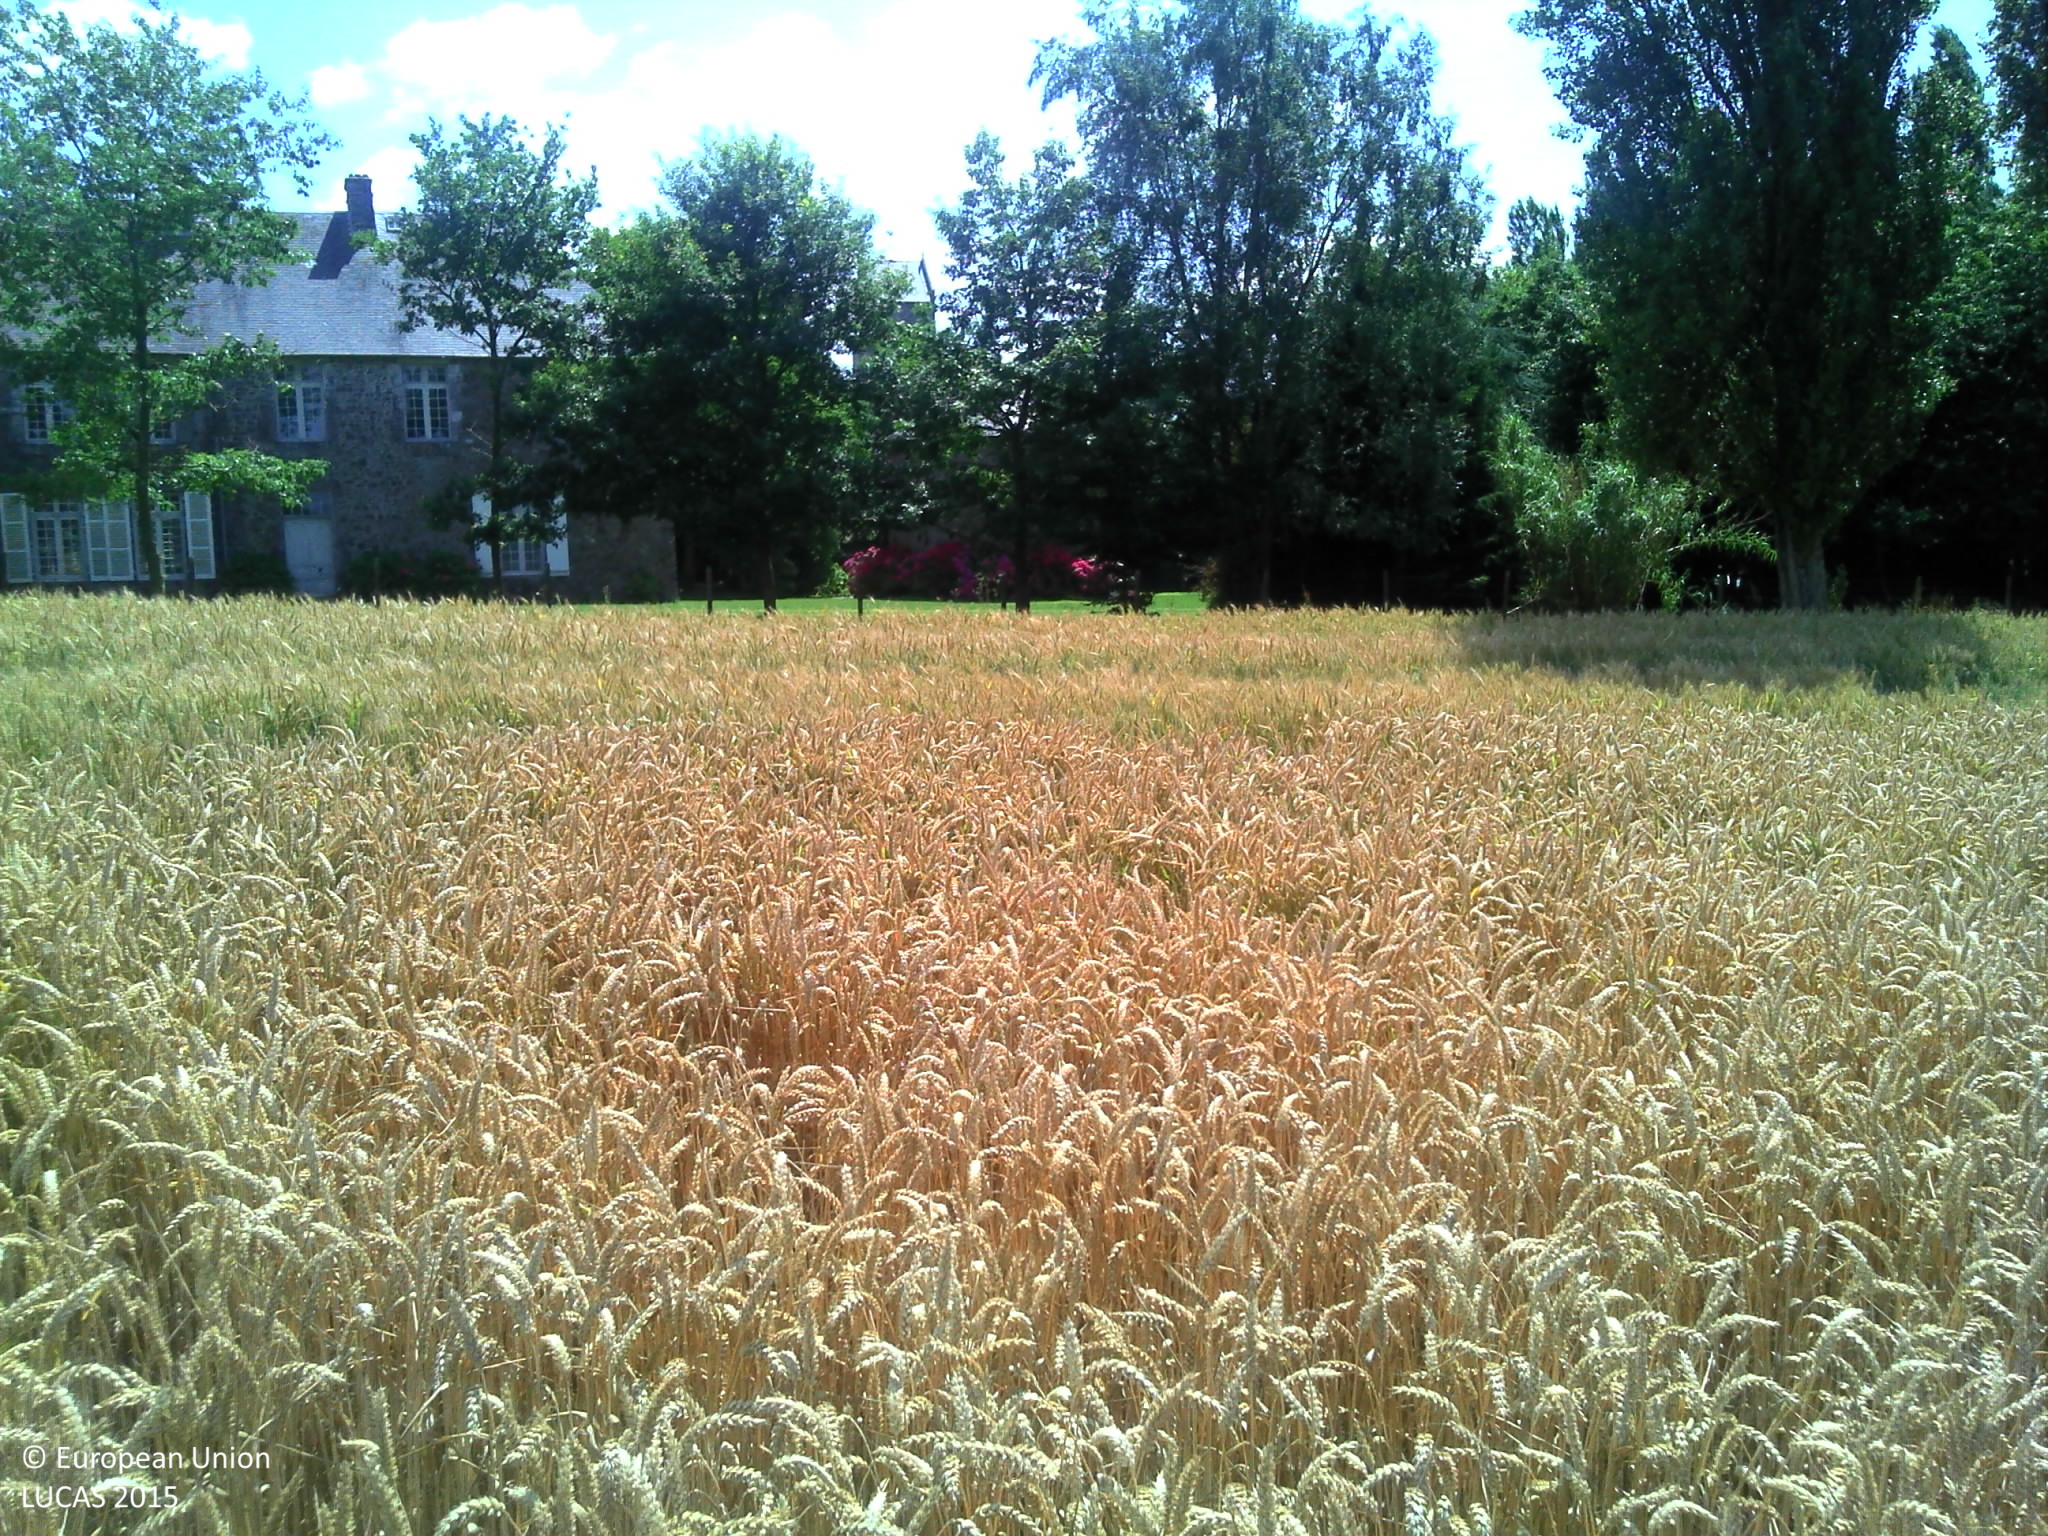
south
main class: Cropland
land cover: Common wheat
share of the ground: > 75 %
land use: Agriculture (excluding fallow land and kitchen gardens)
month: July
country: FR
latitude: 48.9895
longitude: -1.4312
